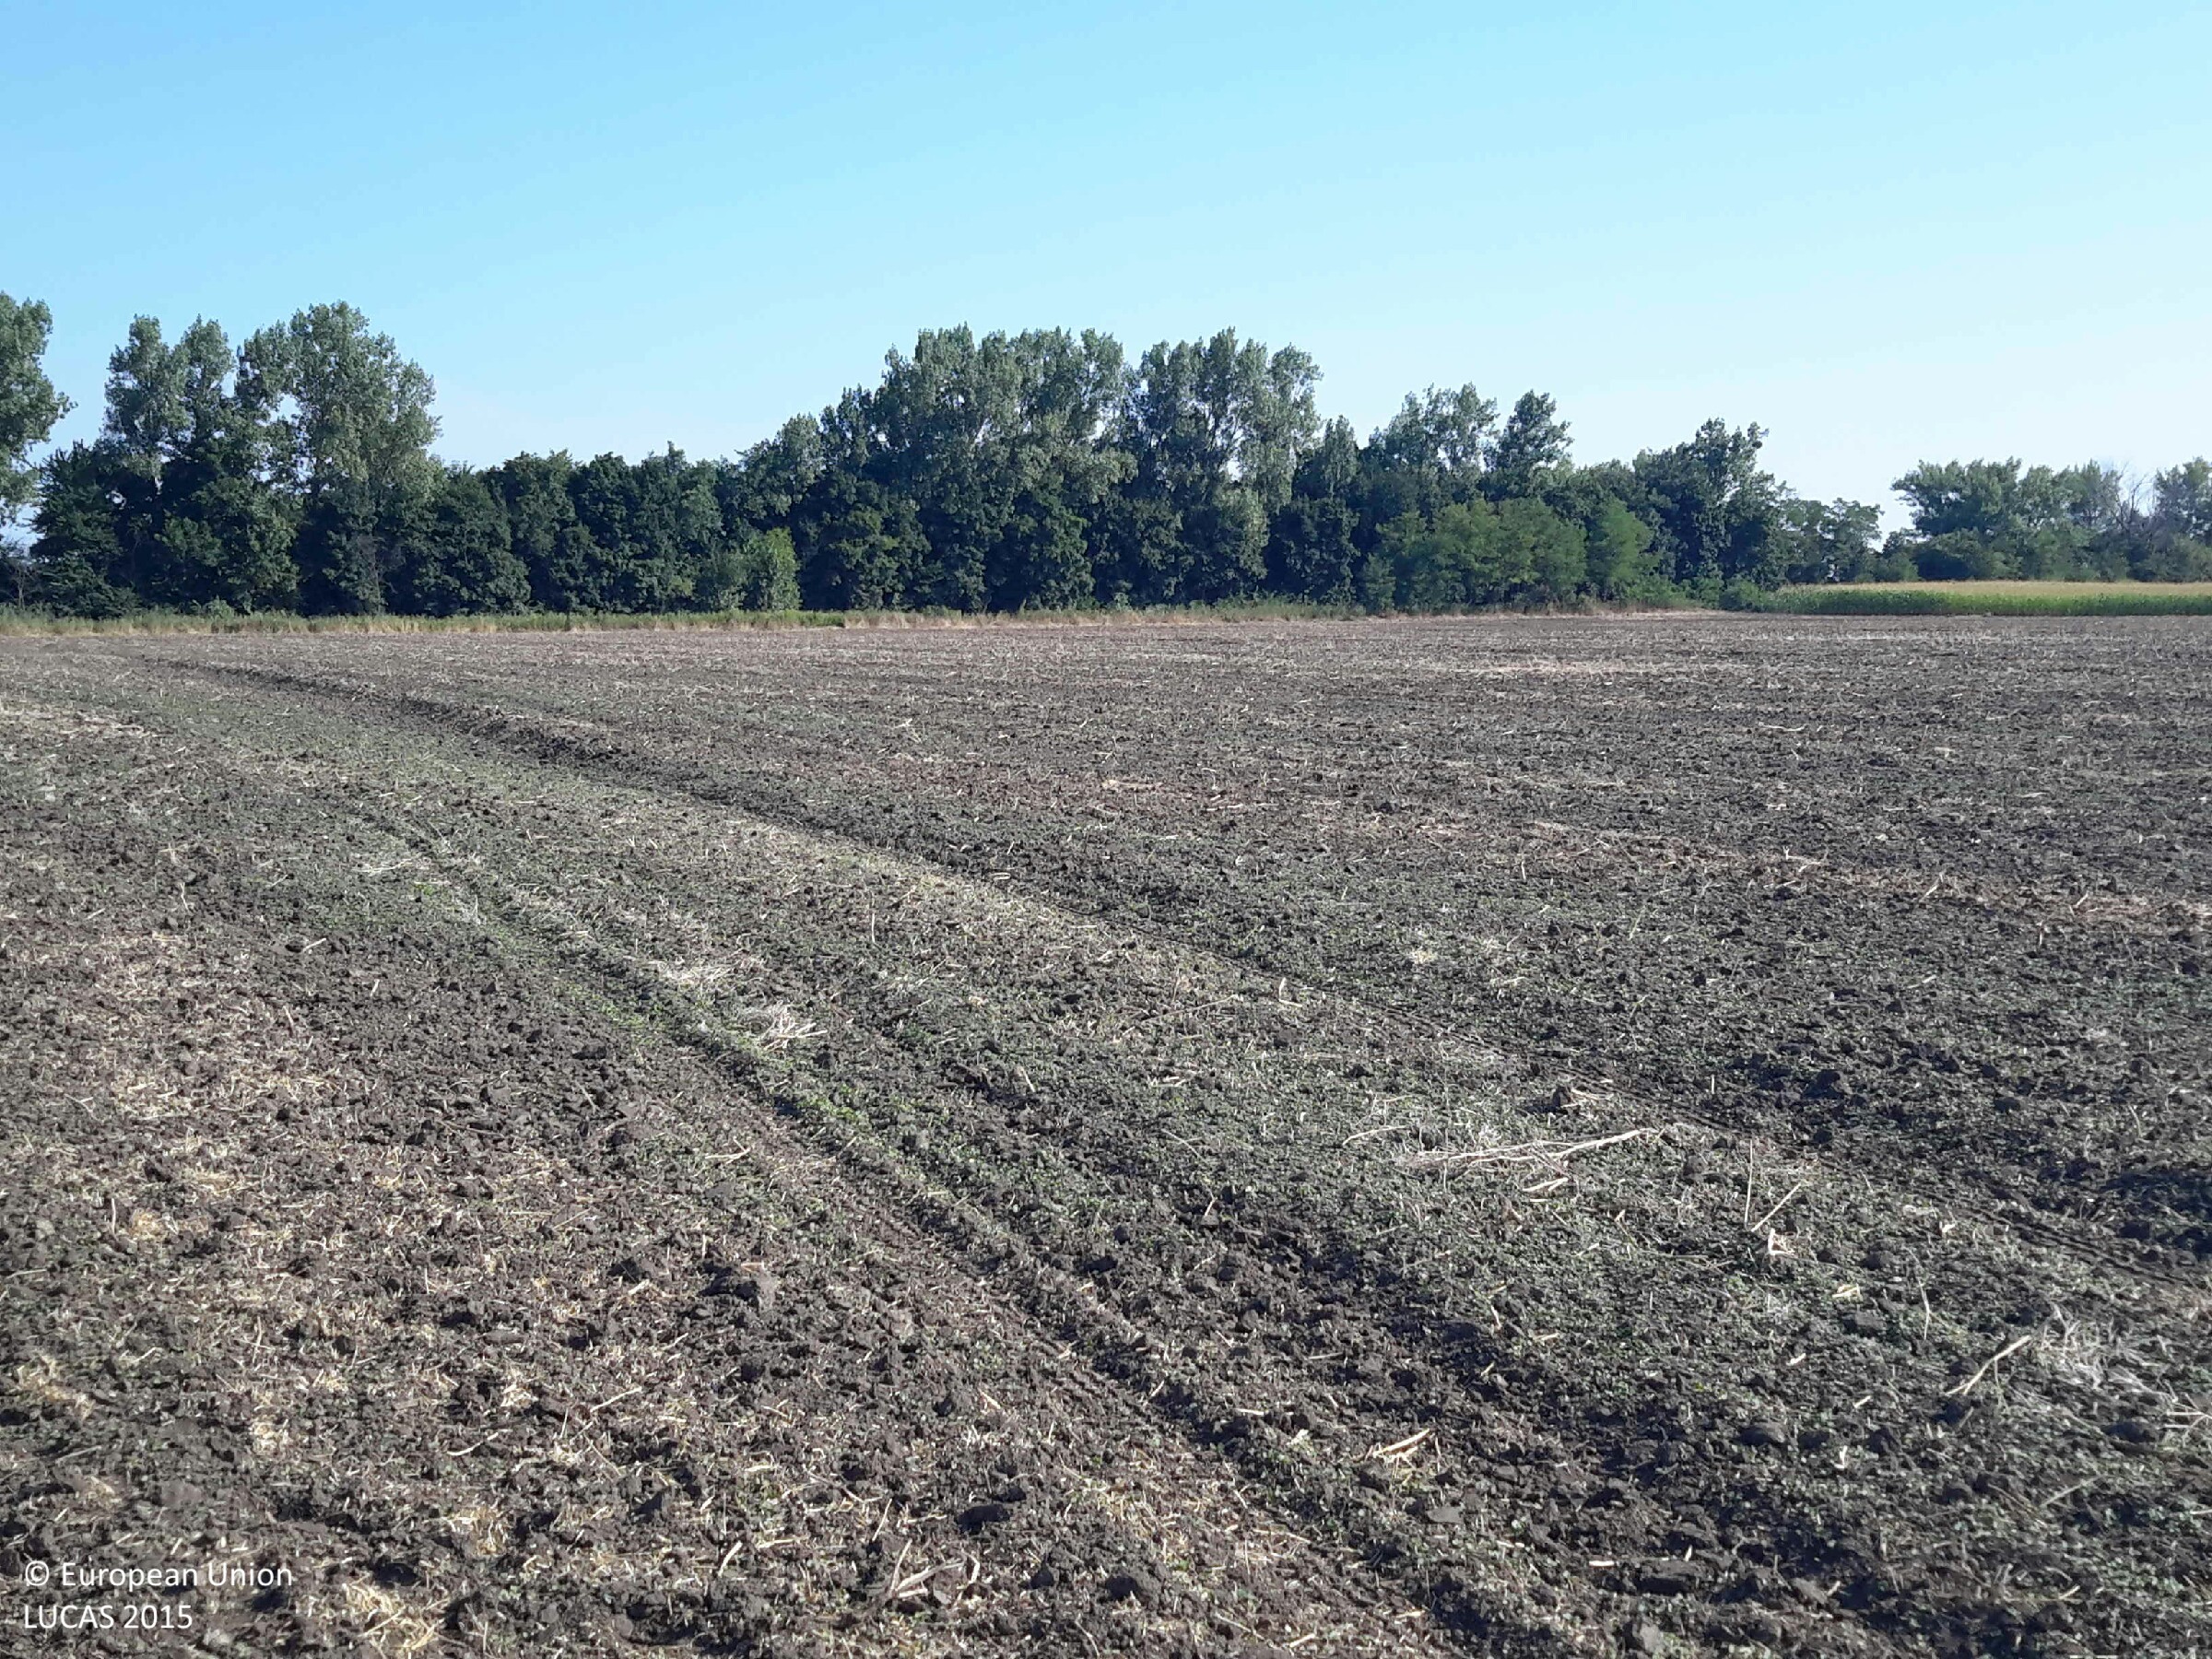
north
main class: Cropland
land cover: Rape and turnip rape
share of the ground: < 10 %
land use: Agriculture (excluding fallow land and kitchen gardens)
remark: Harvested field
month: July
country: HU
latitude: 47.5268
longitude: 17.8597
